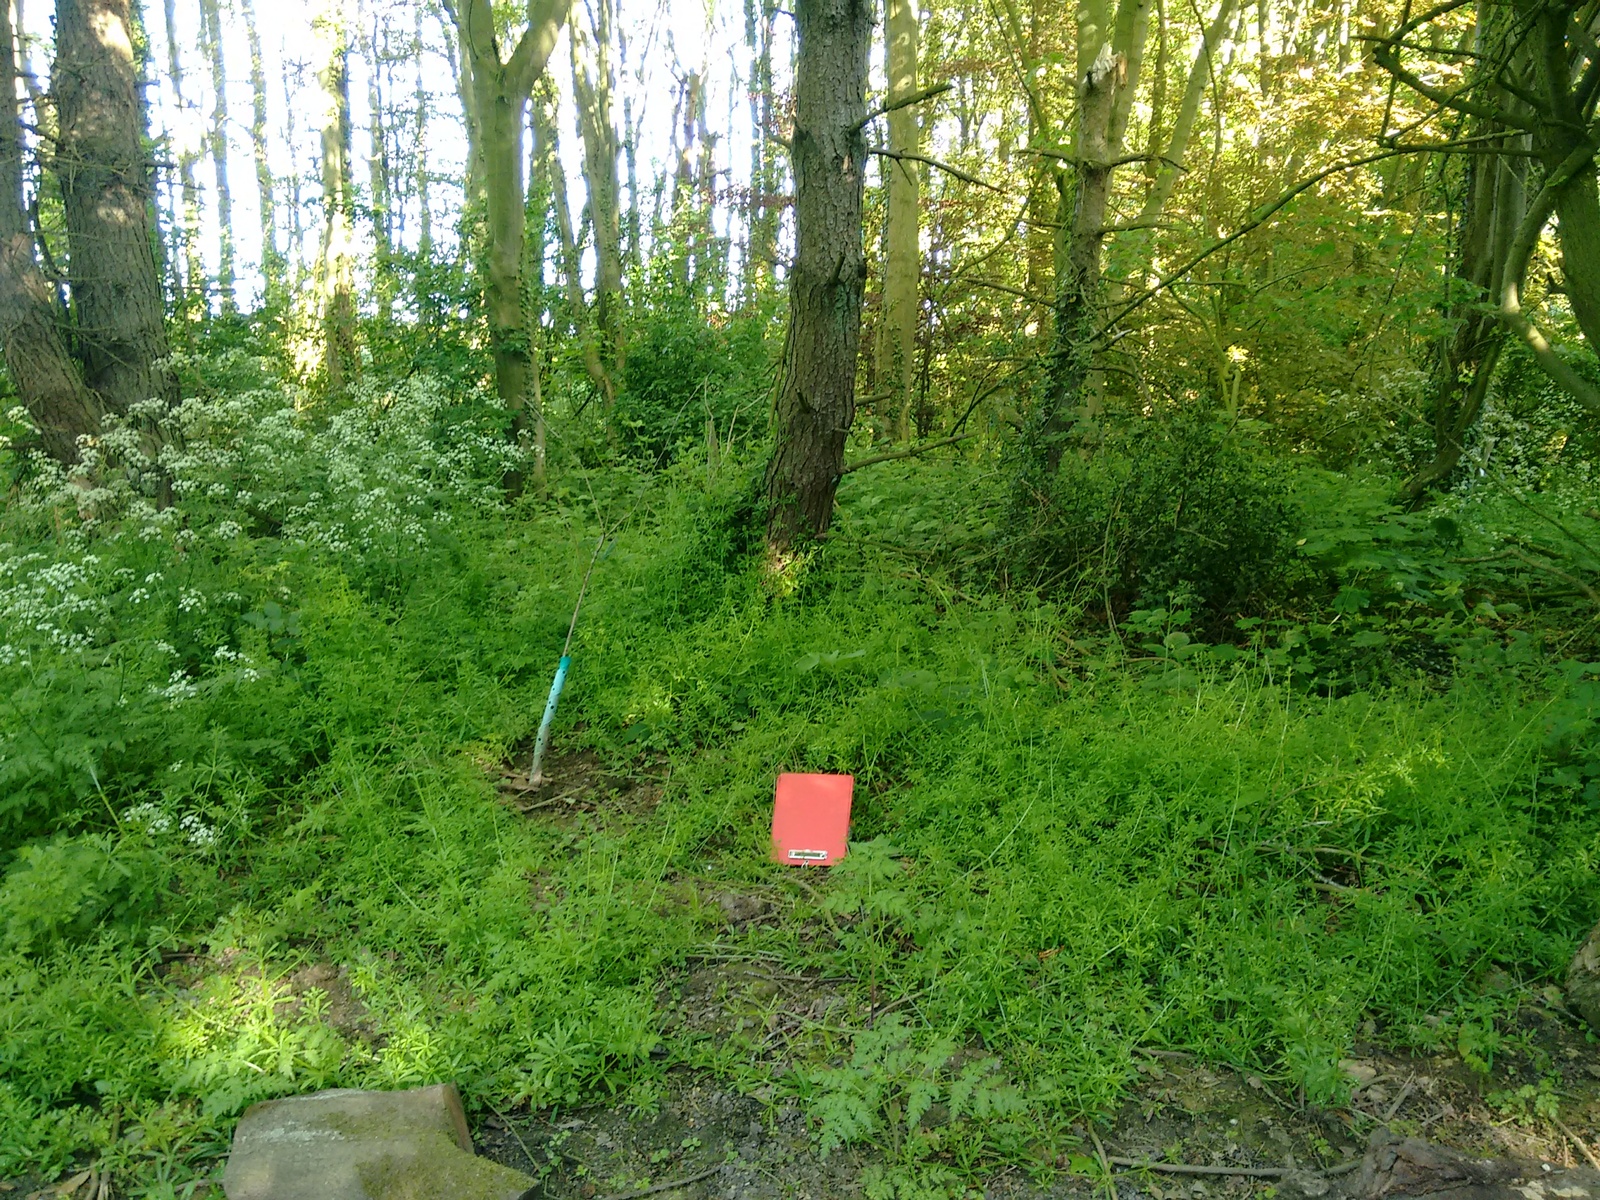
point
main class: Woodland
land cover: Broadleaved woodland
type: mesophytic deciduous forest
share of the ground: > 75 %
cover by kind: broadleaved forest trees 90 %, shrubs 10 %
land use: Amenities, museums, leisure
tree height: > 5 m
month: May
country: GB
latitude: 51.1649
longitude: 1.2121
